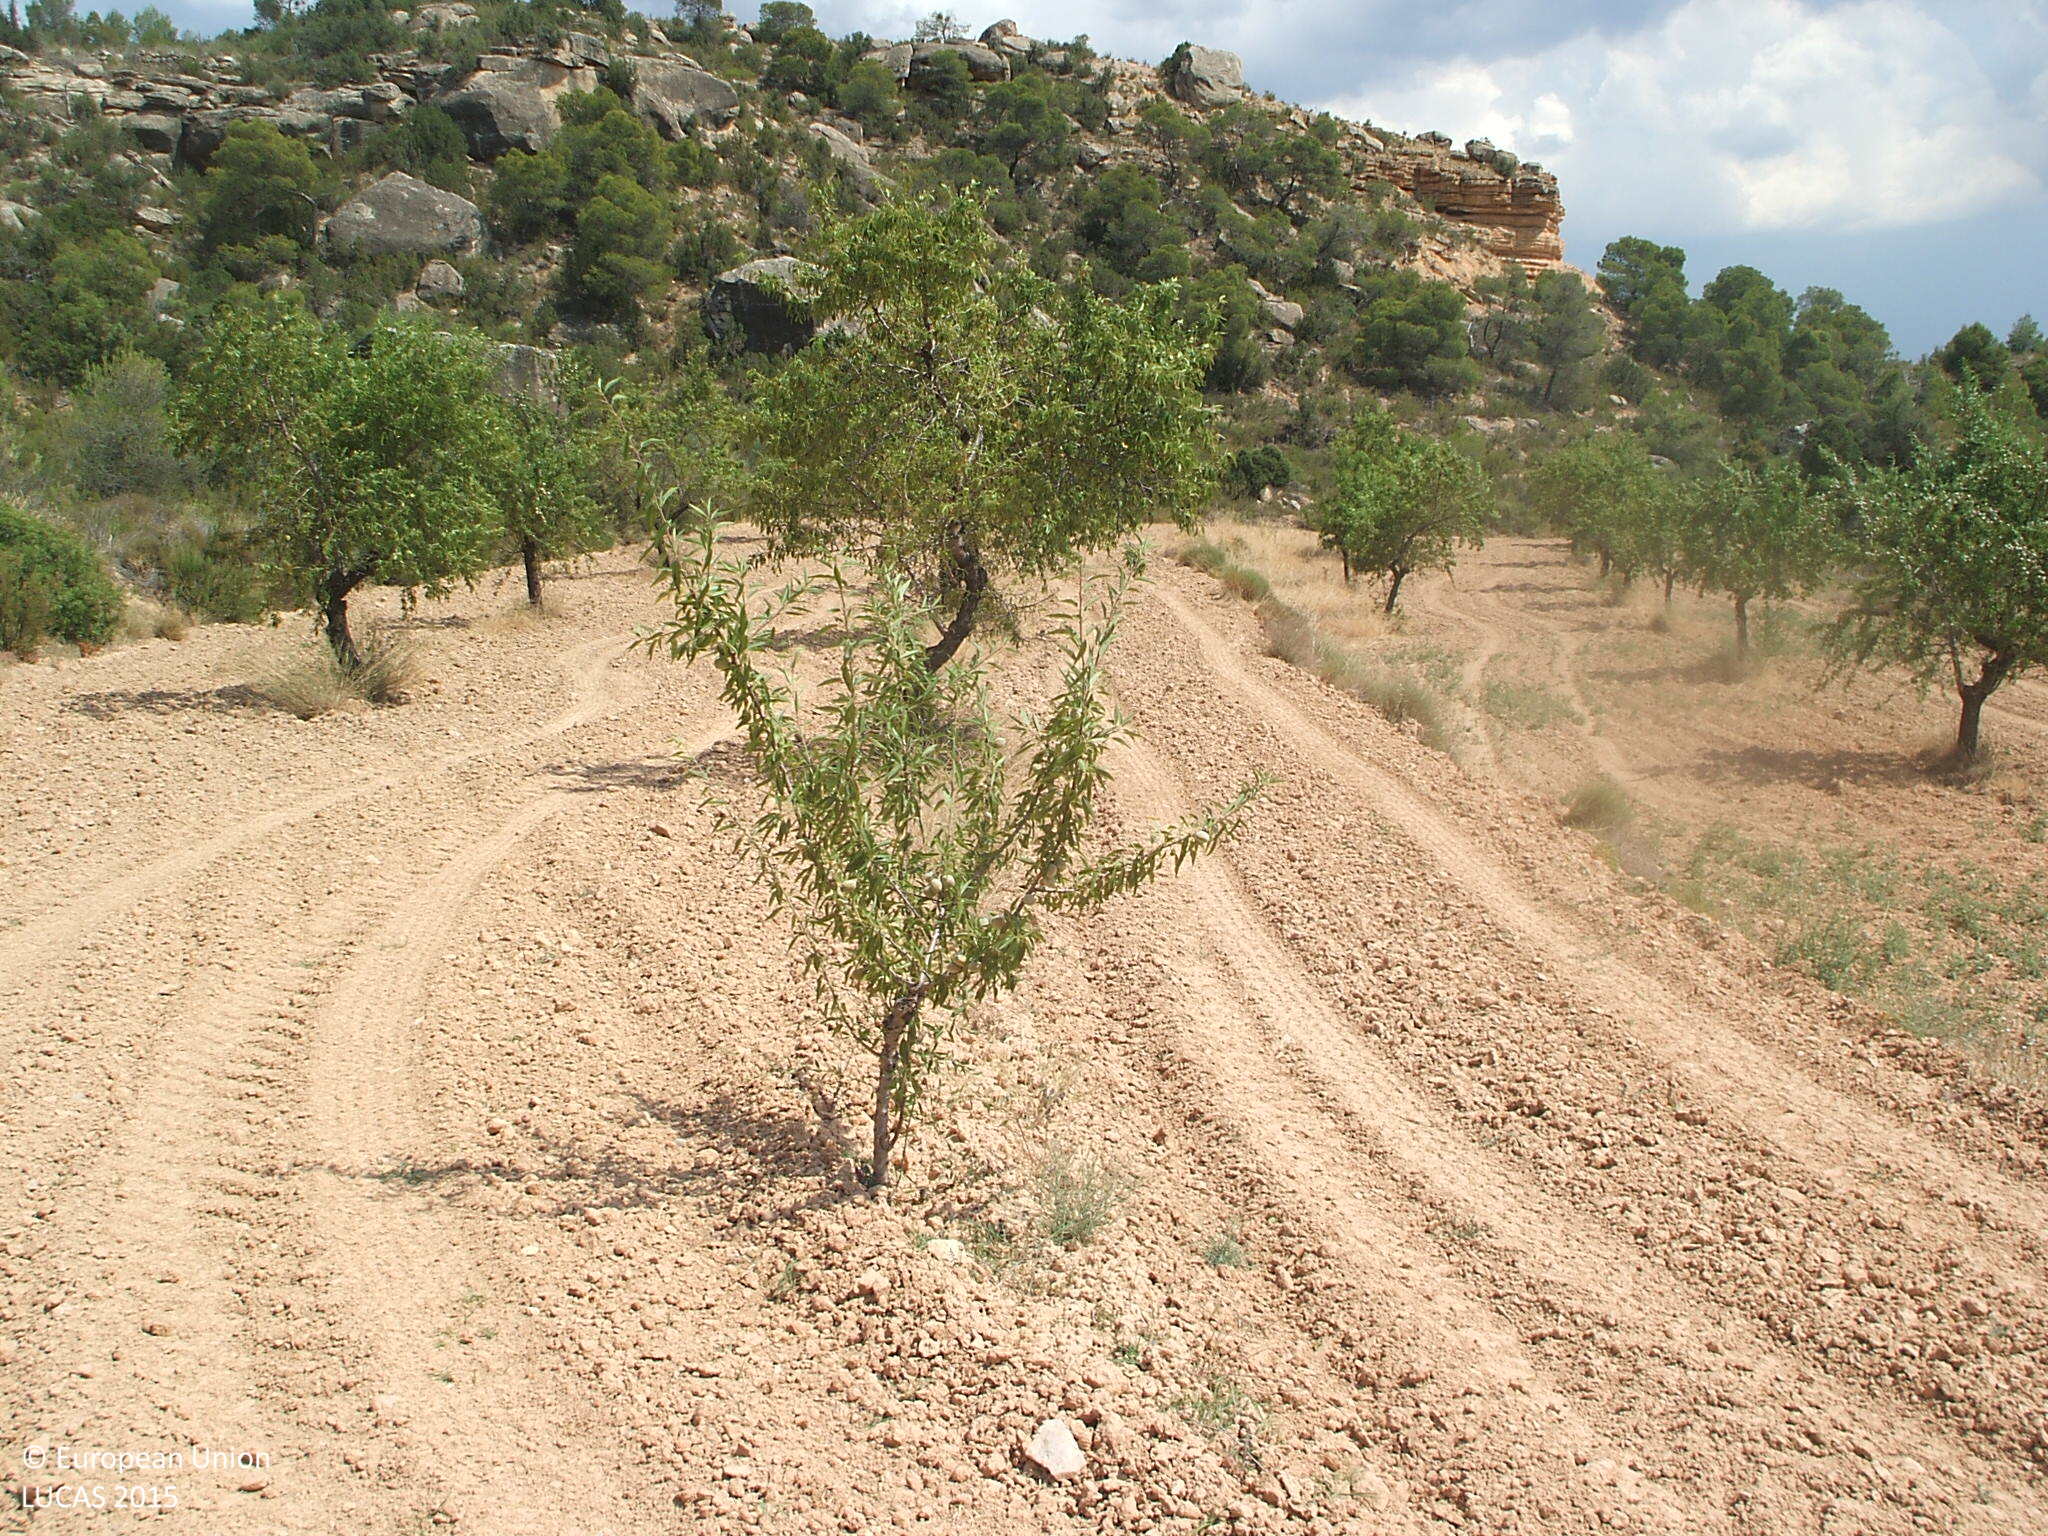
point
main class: Cropland
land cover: Nuts trees
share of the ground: < 10 %
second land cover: Other bare soil
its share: > 75 %
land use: Agriculture (excluding fallow land and kitchen gardens)
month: June
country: ES
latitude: 41.1003
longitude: -0.0247
